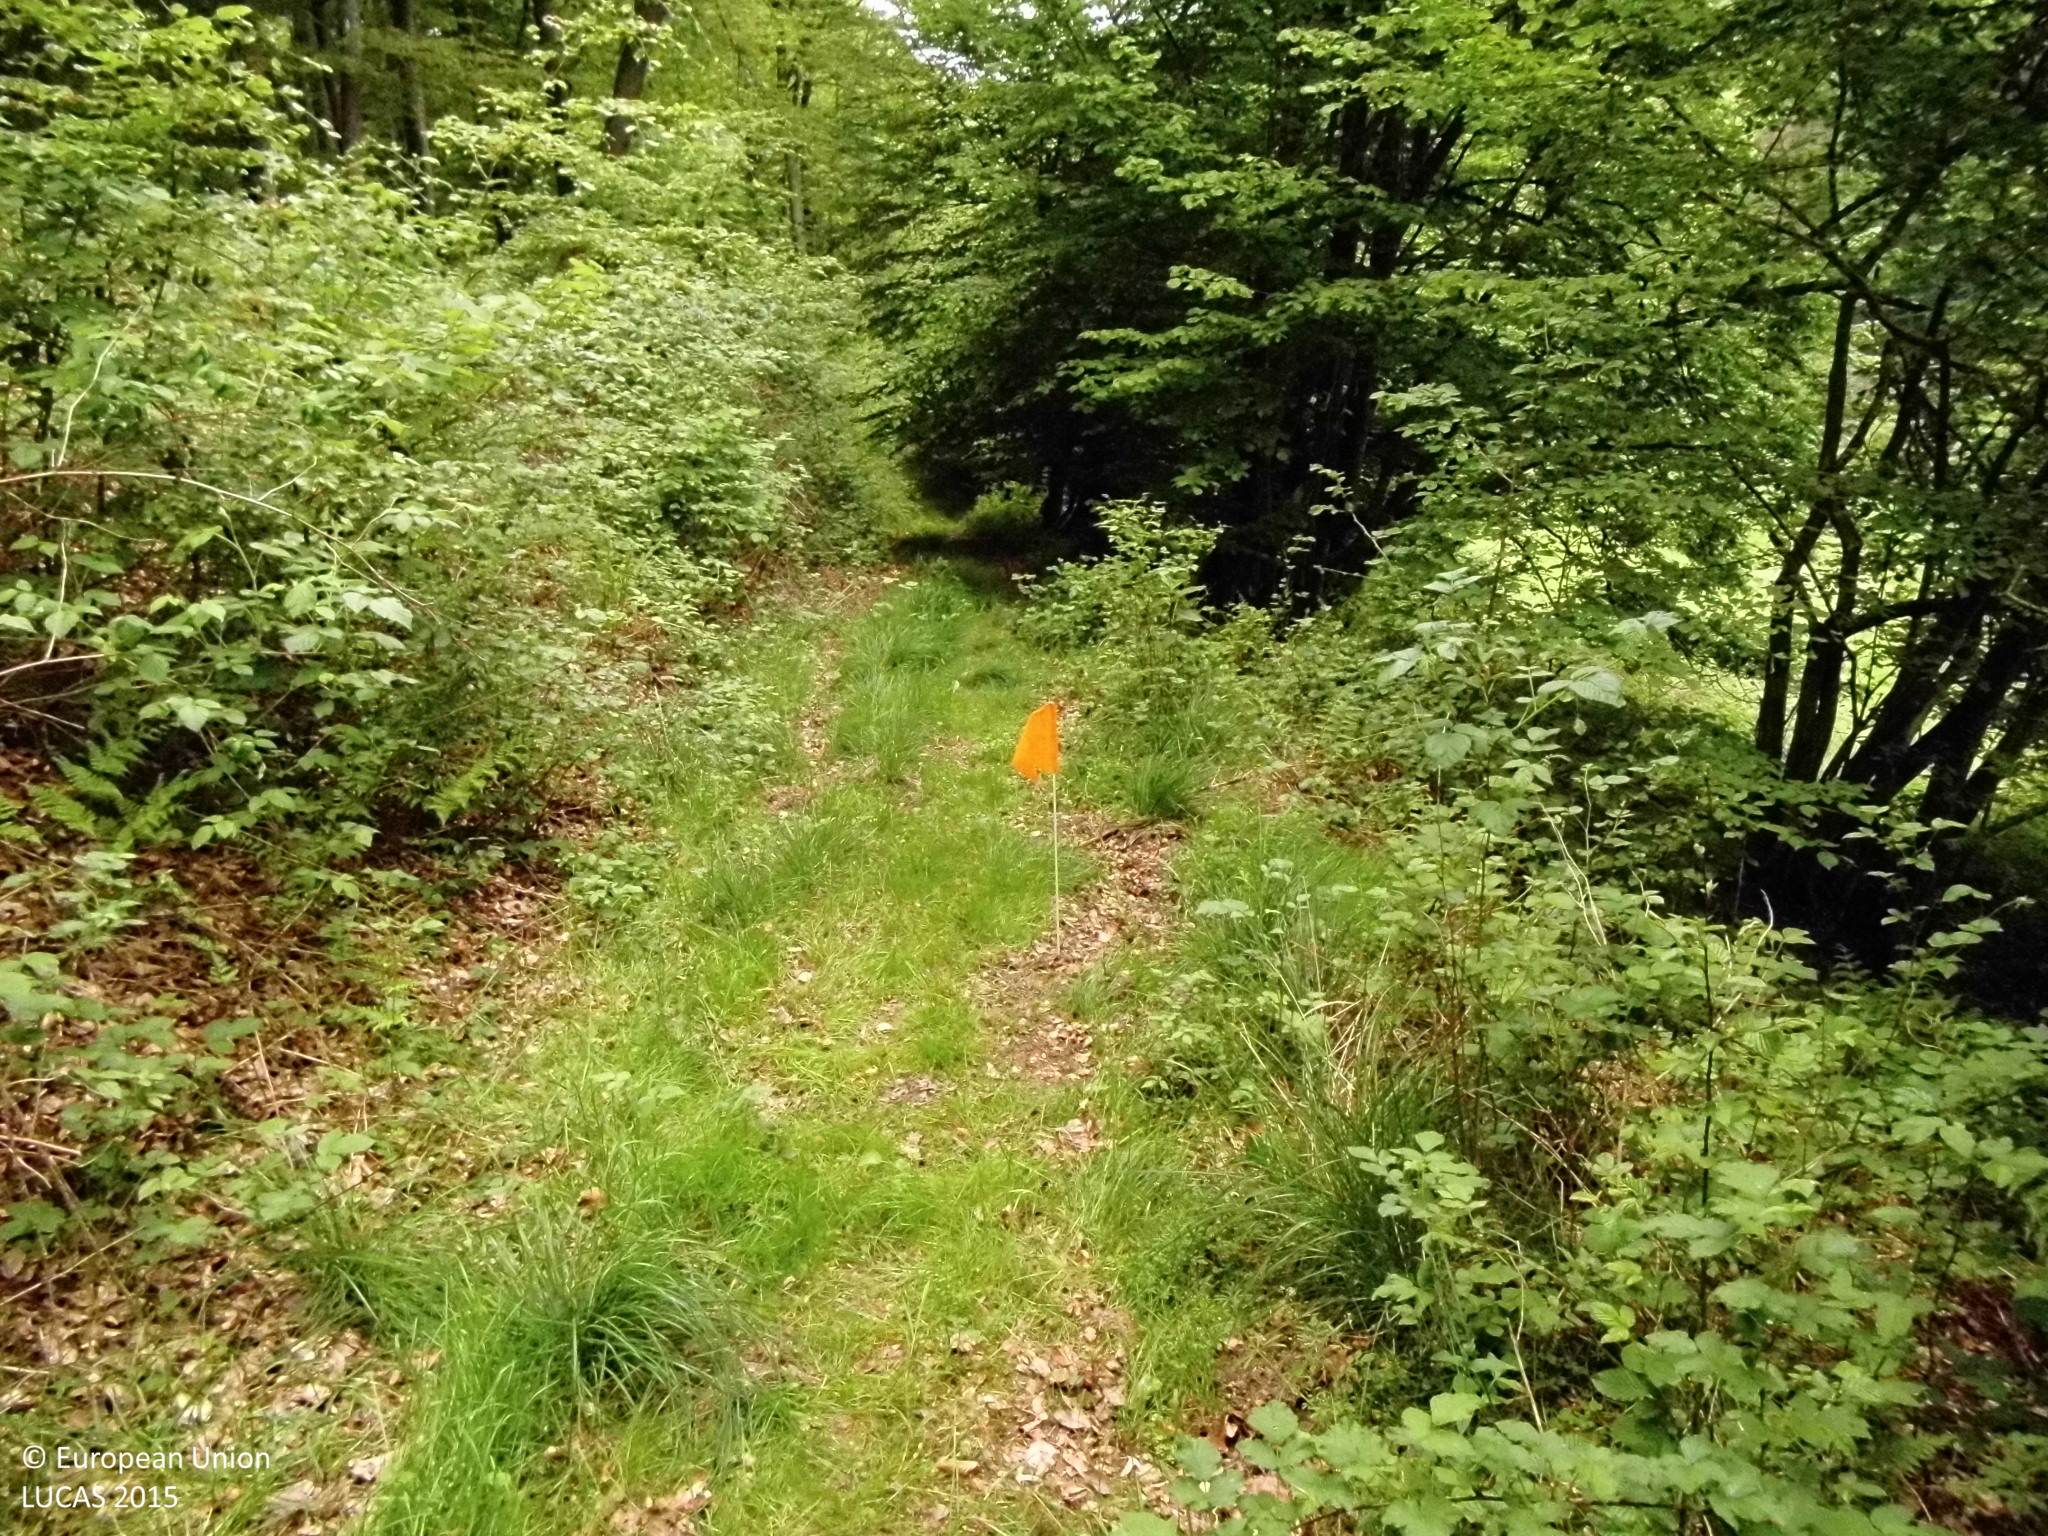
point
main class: Woodland
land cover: Broadleaved woodland
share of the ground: 50 - 75 %
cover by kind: broadleaved forest trees 70 %, shrubs 15 %, herbaceous plants 15 %
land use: Forestry
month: May
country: DE
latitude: 50.5527
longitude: 7.5021
